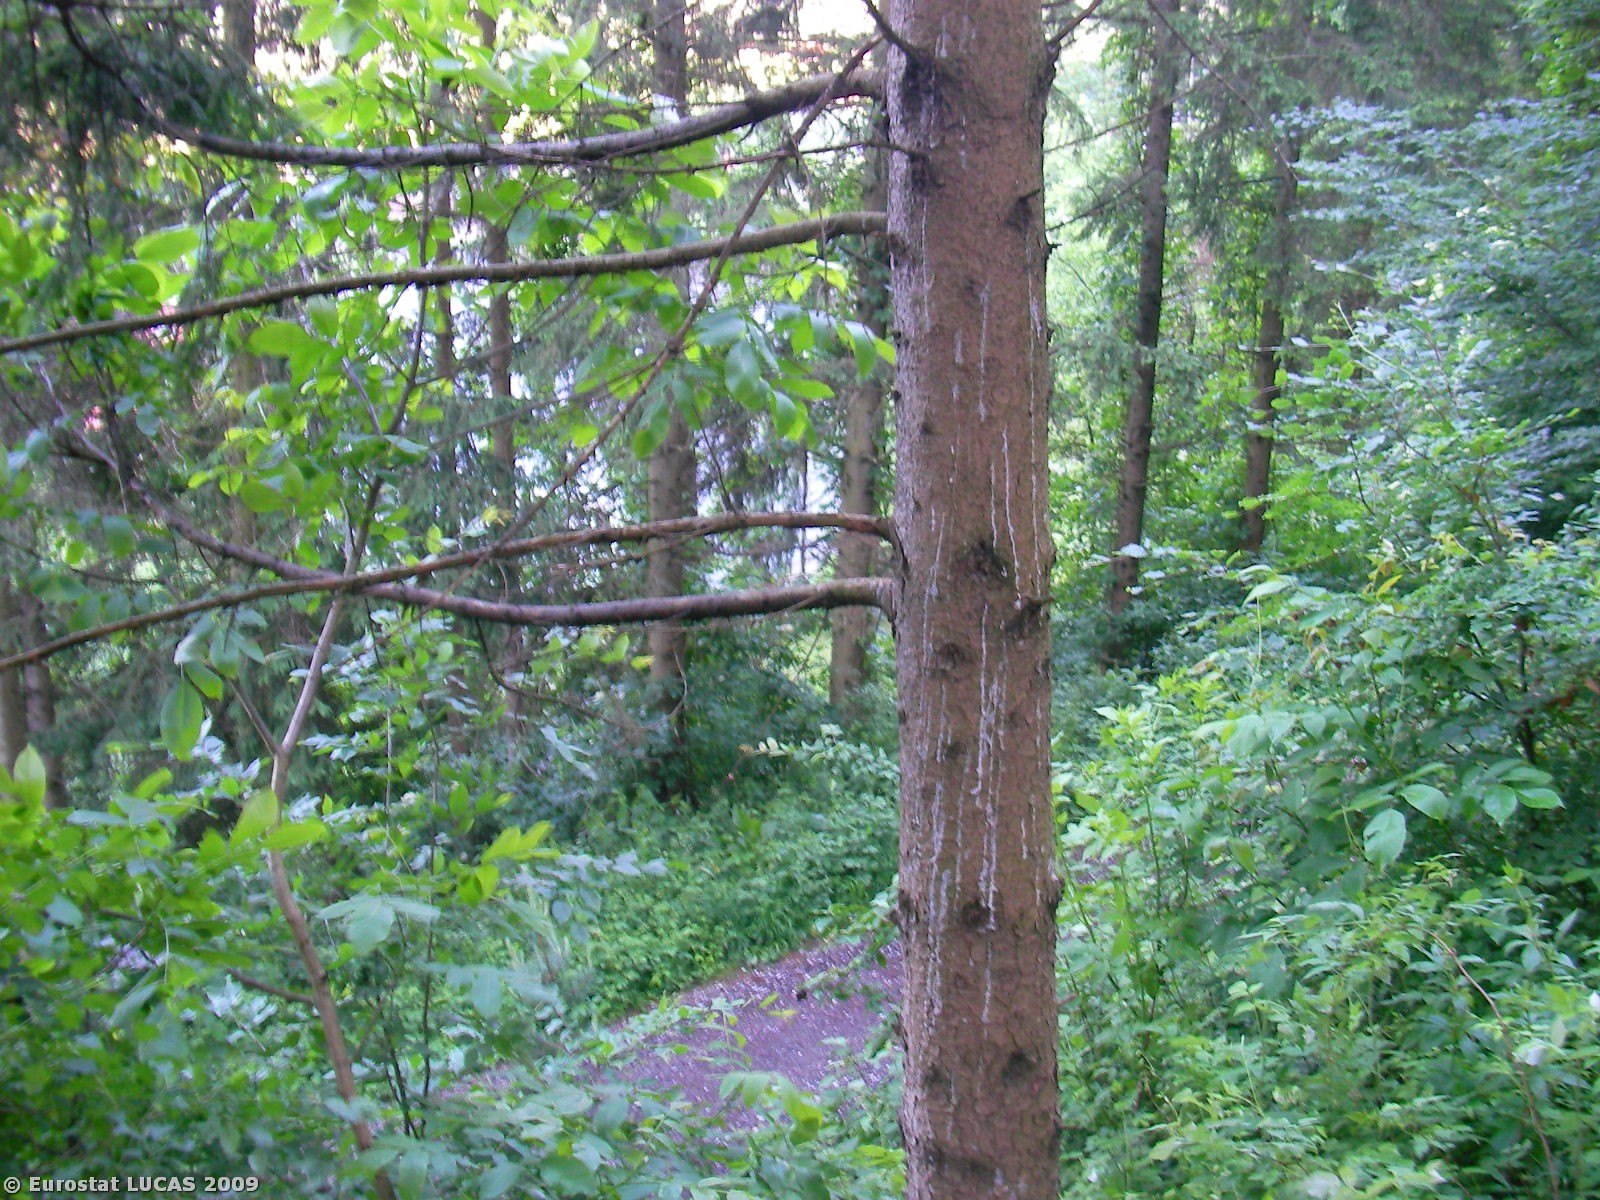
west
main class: Woodland
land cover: Coniferous woodland
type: hemiboreal forest and nemoral coniferous forest and mixed broadleaved-coniferous forest
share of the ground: > 75 %
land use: Forestry
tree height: > 5 m
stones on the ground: < 10 %
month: May
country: AT
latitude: 47.2831
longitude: 15.3282
